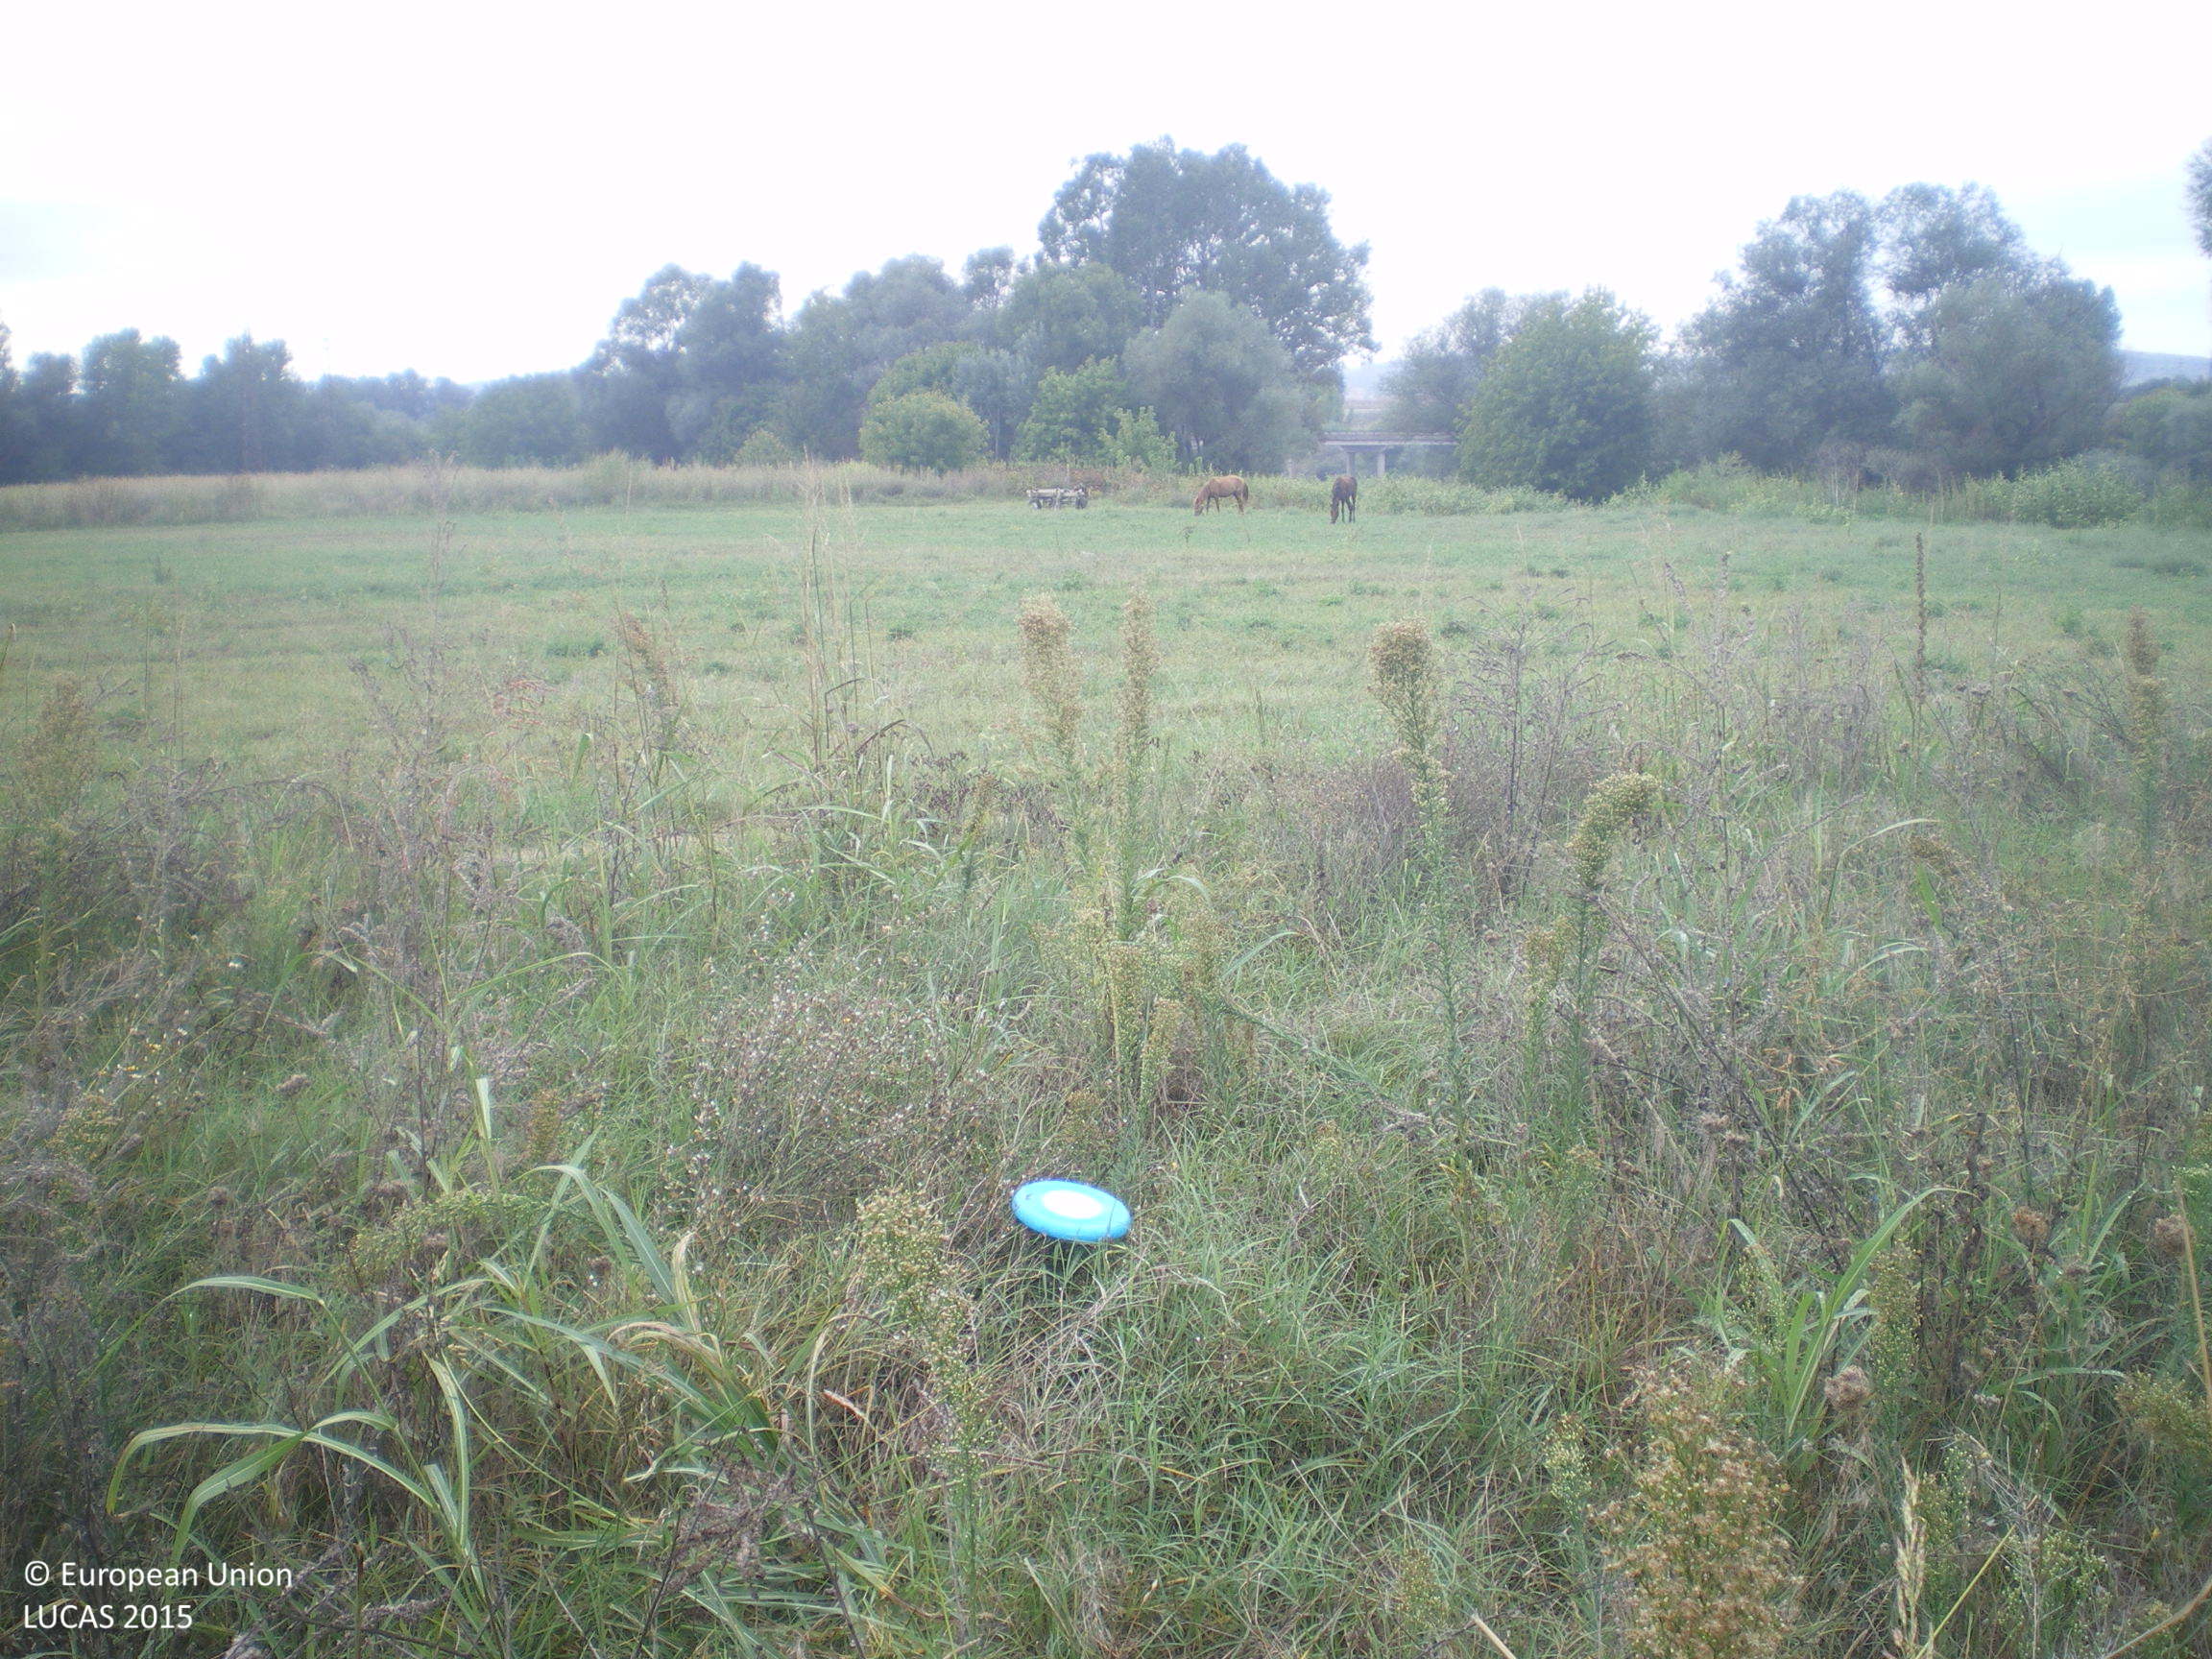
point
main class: Grassland
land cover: Spontaneously vegetated surfaces
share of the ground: > 75 %
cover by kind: herbaceous plants 100 %
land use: Fallow land
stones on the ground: < 10 %
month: September
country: BG
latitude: 41.9348
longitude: 25.9316
